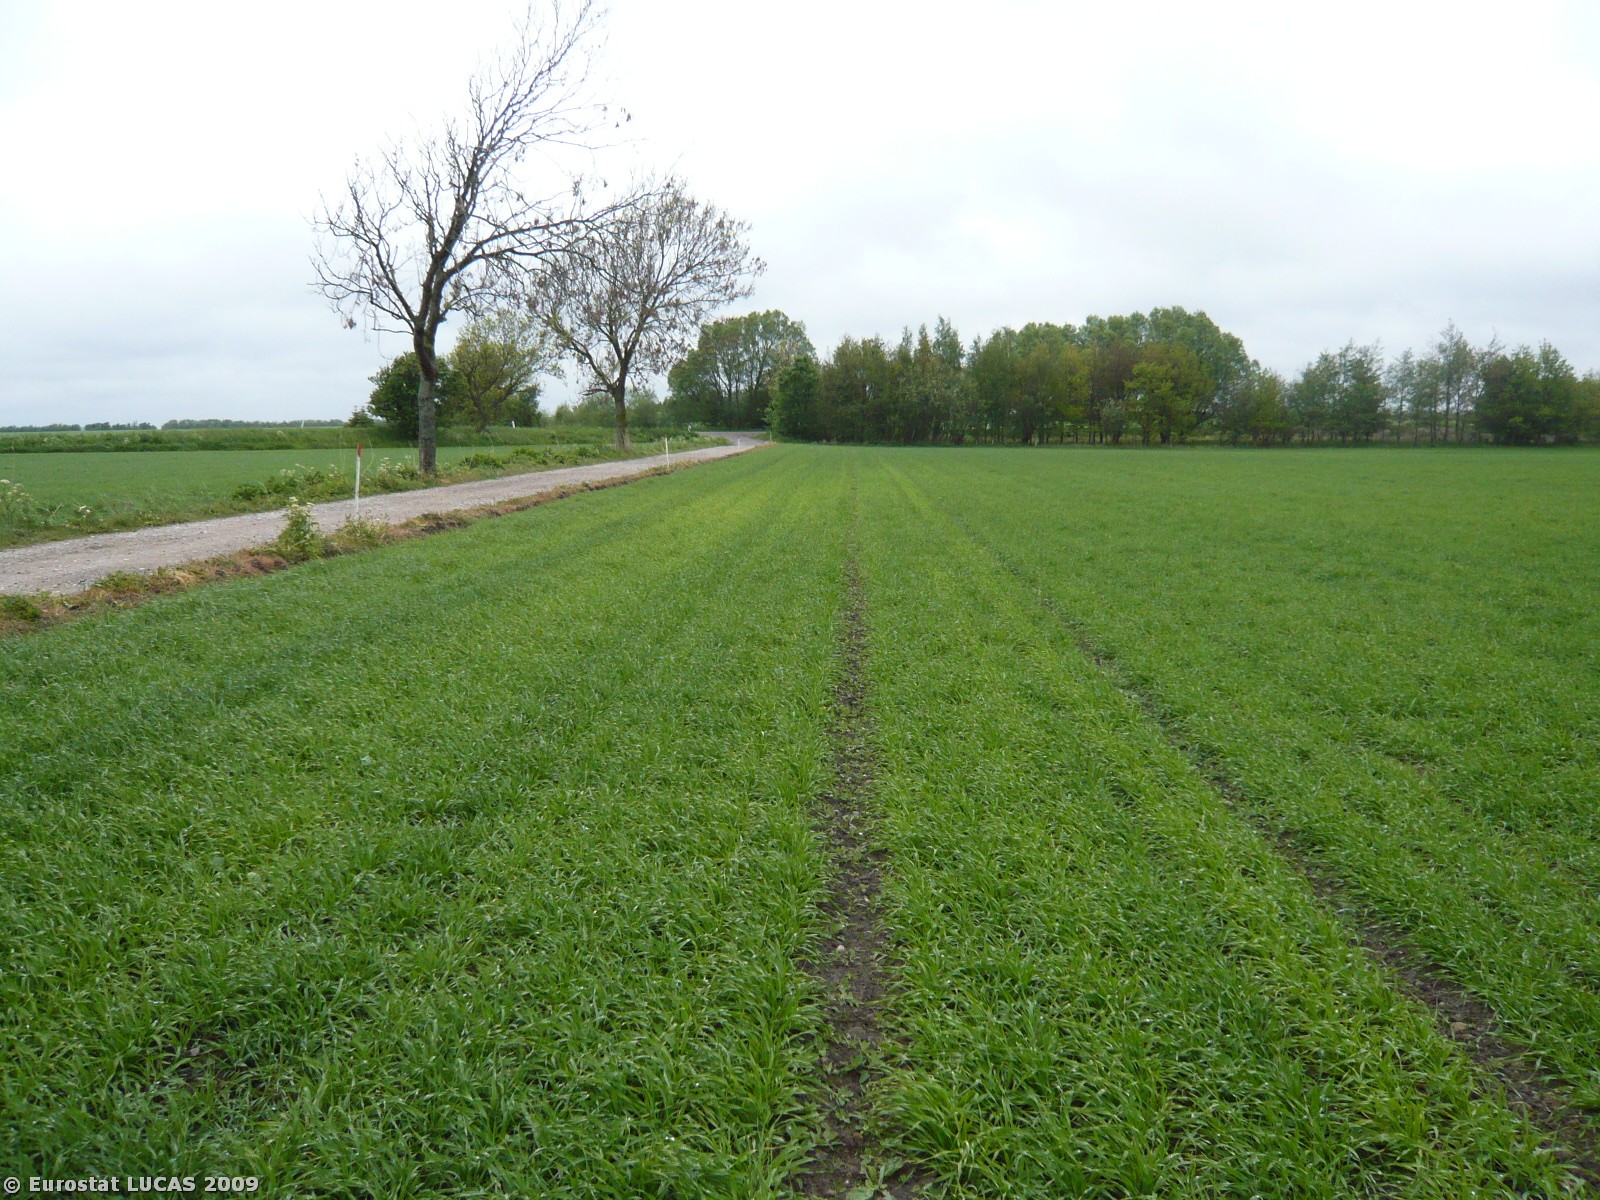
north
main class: Cropland
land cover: Barley
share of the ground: > 75 %
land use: Agriculture (excluding fallow land and kitchen gardens)
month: May
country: DK
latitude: 55.1148
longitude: 11.7703
